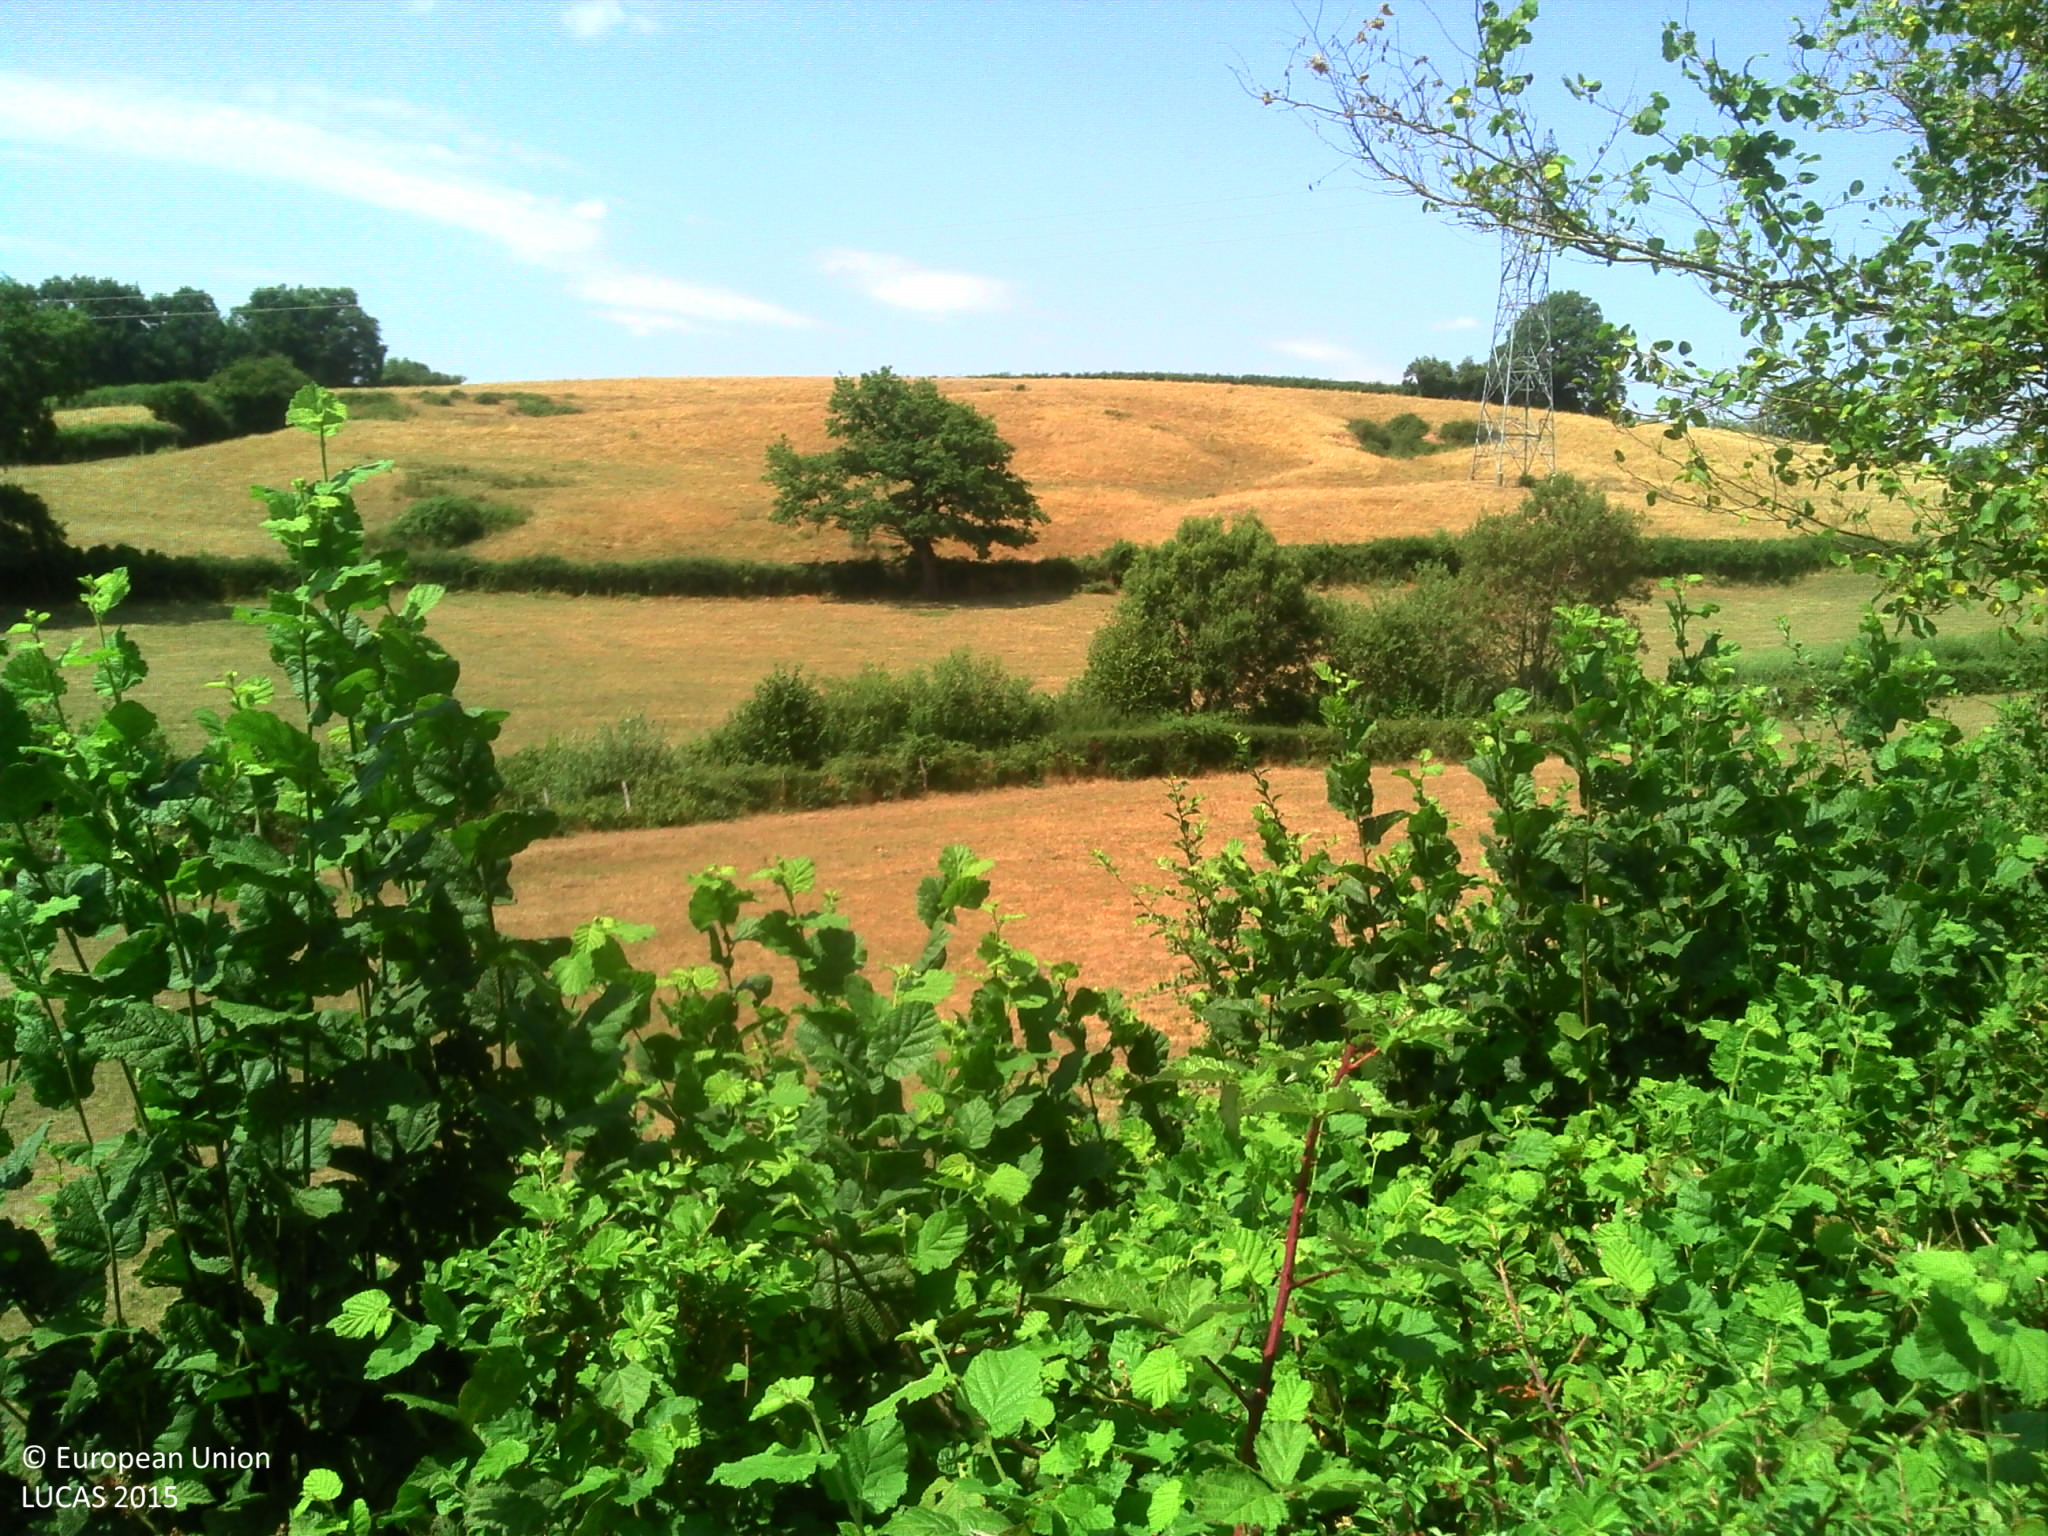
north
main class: Grassland
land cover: Grassland without tree/shrub cover
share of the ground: > 75 %
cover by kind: herbaceous plants 100 %
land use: Agriculture (excluding fallow land and kitchen gardens)
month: July
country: FR
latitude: 46.5644
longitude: 4.3783
